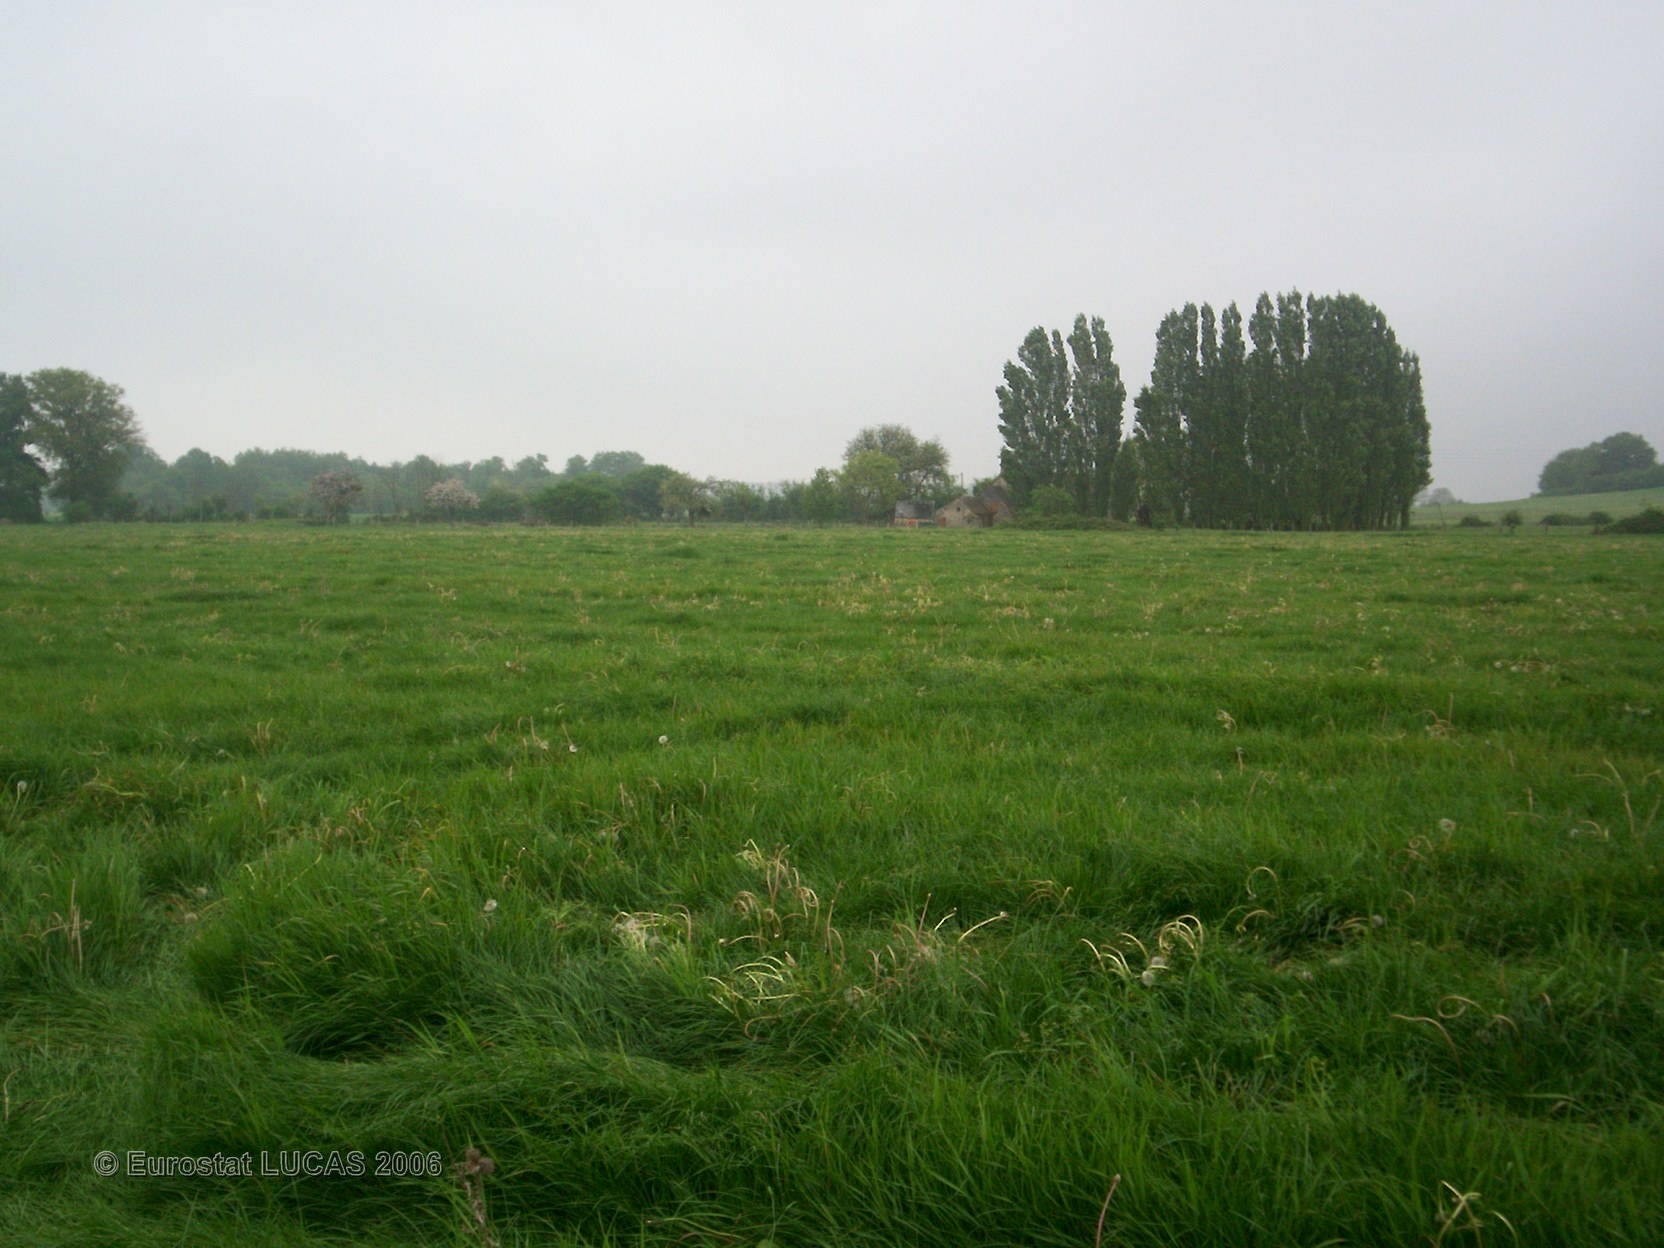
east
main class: Grassland
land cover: Grassland without tree/shrub cover
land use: Agriculture (excluding fallow land and kitchen gardens)
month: May
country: FR
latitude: 47.9489
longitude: 0.4026
